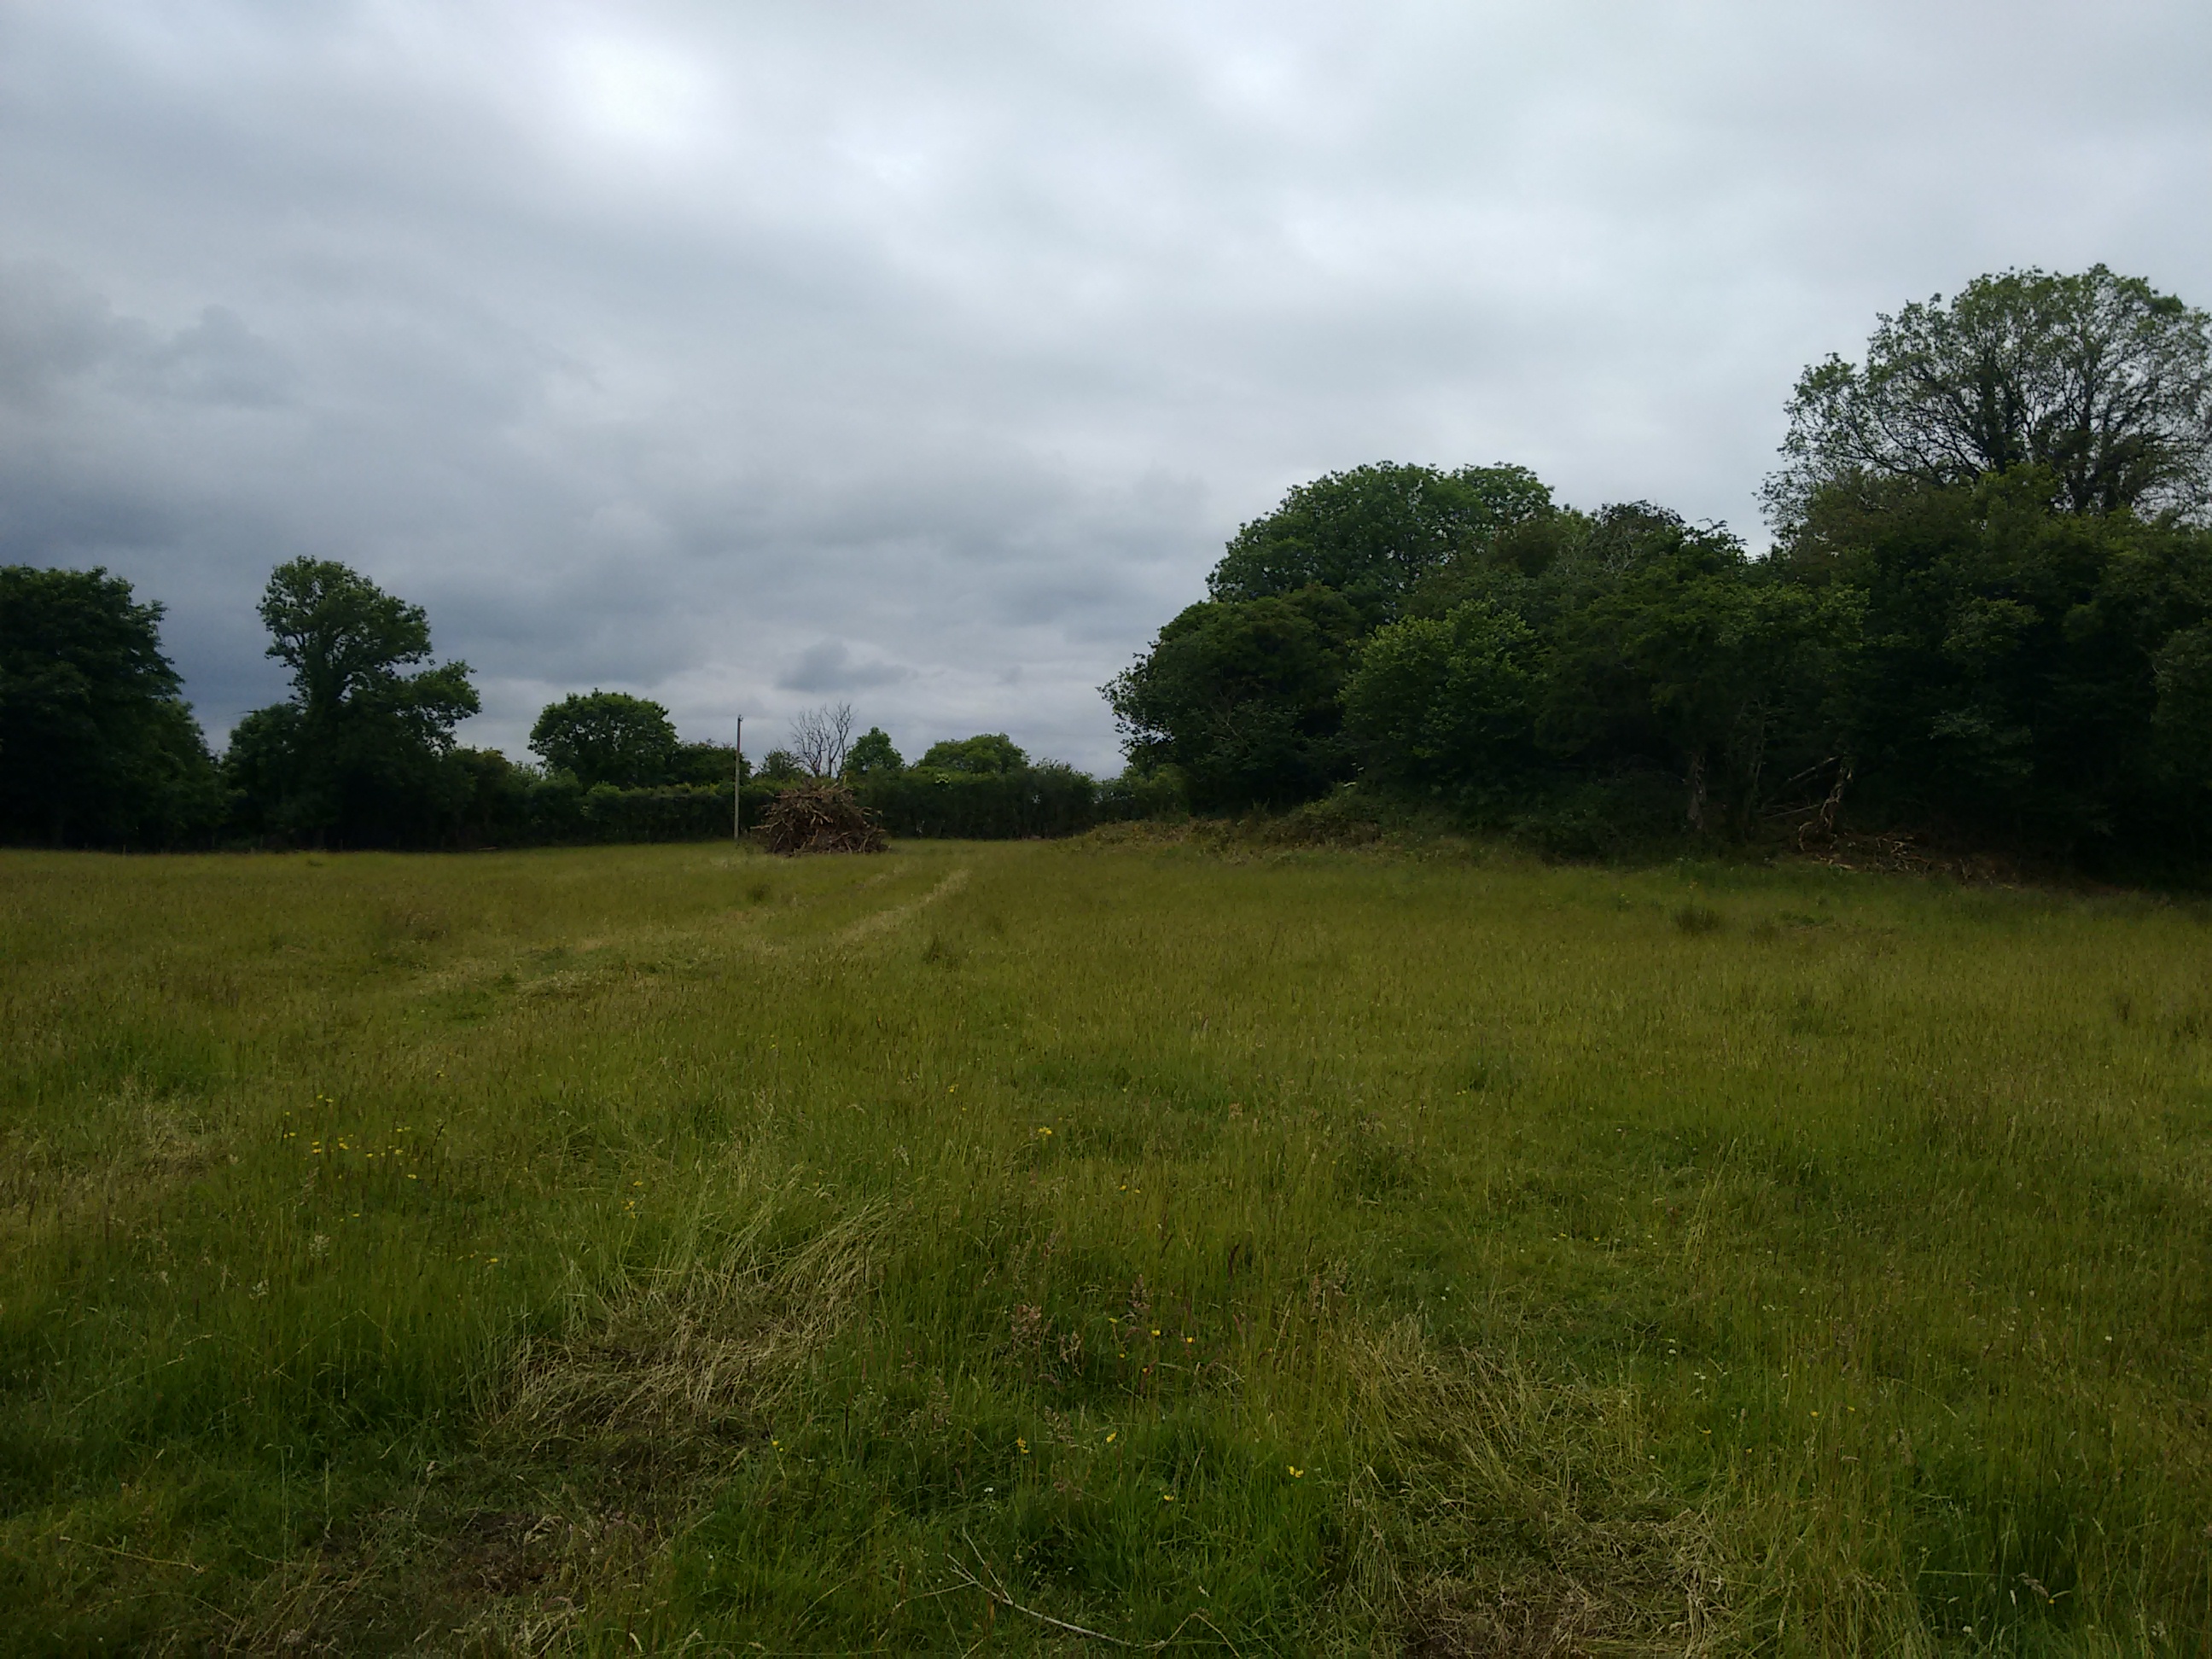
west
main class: Grassland
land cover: Grassland without tree/shrub cover
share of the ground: > 75 %
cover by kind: herbaceous plants 95 %, shrubs 5 %
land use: Agriculture (excluding fallow land and kitchen gardens)
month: June
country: IE
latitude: 53.3983
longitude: -7.7788
